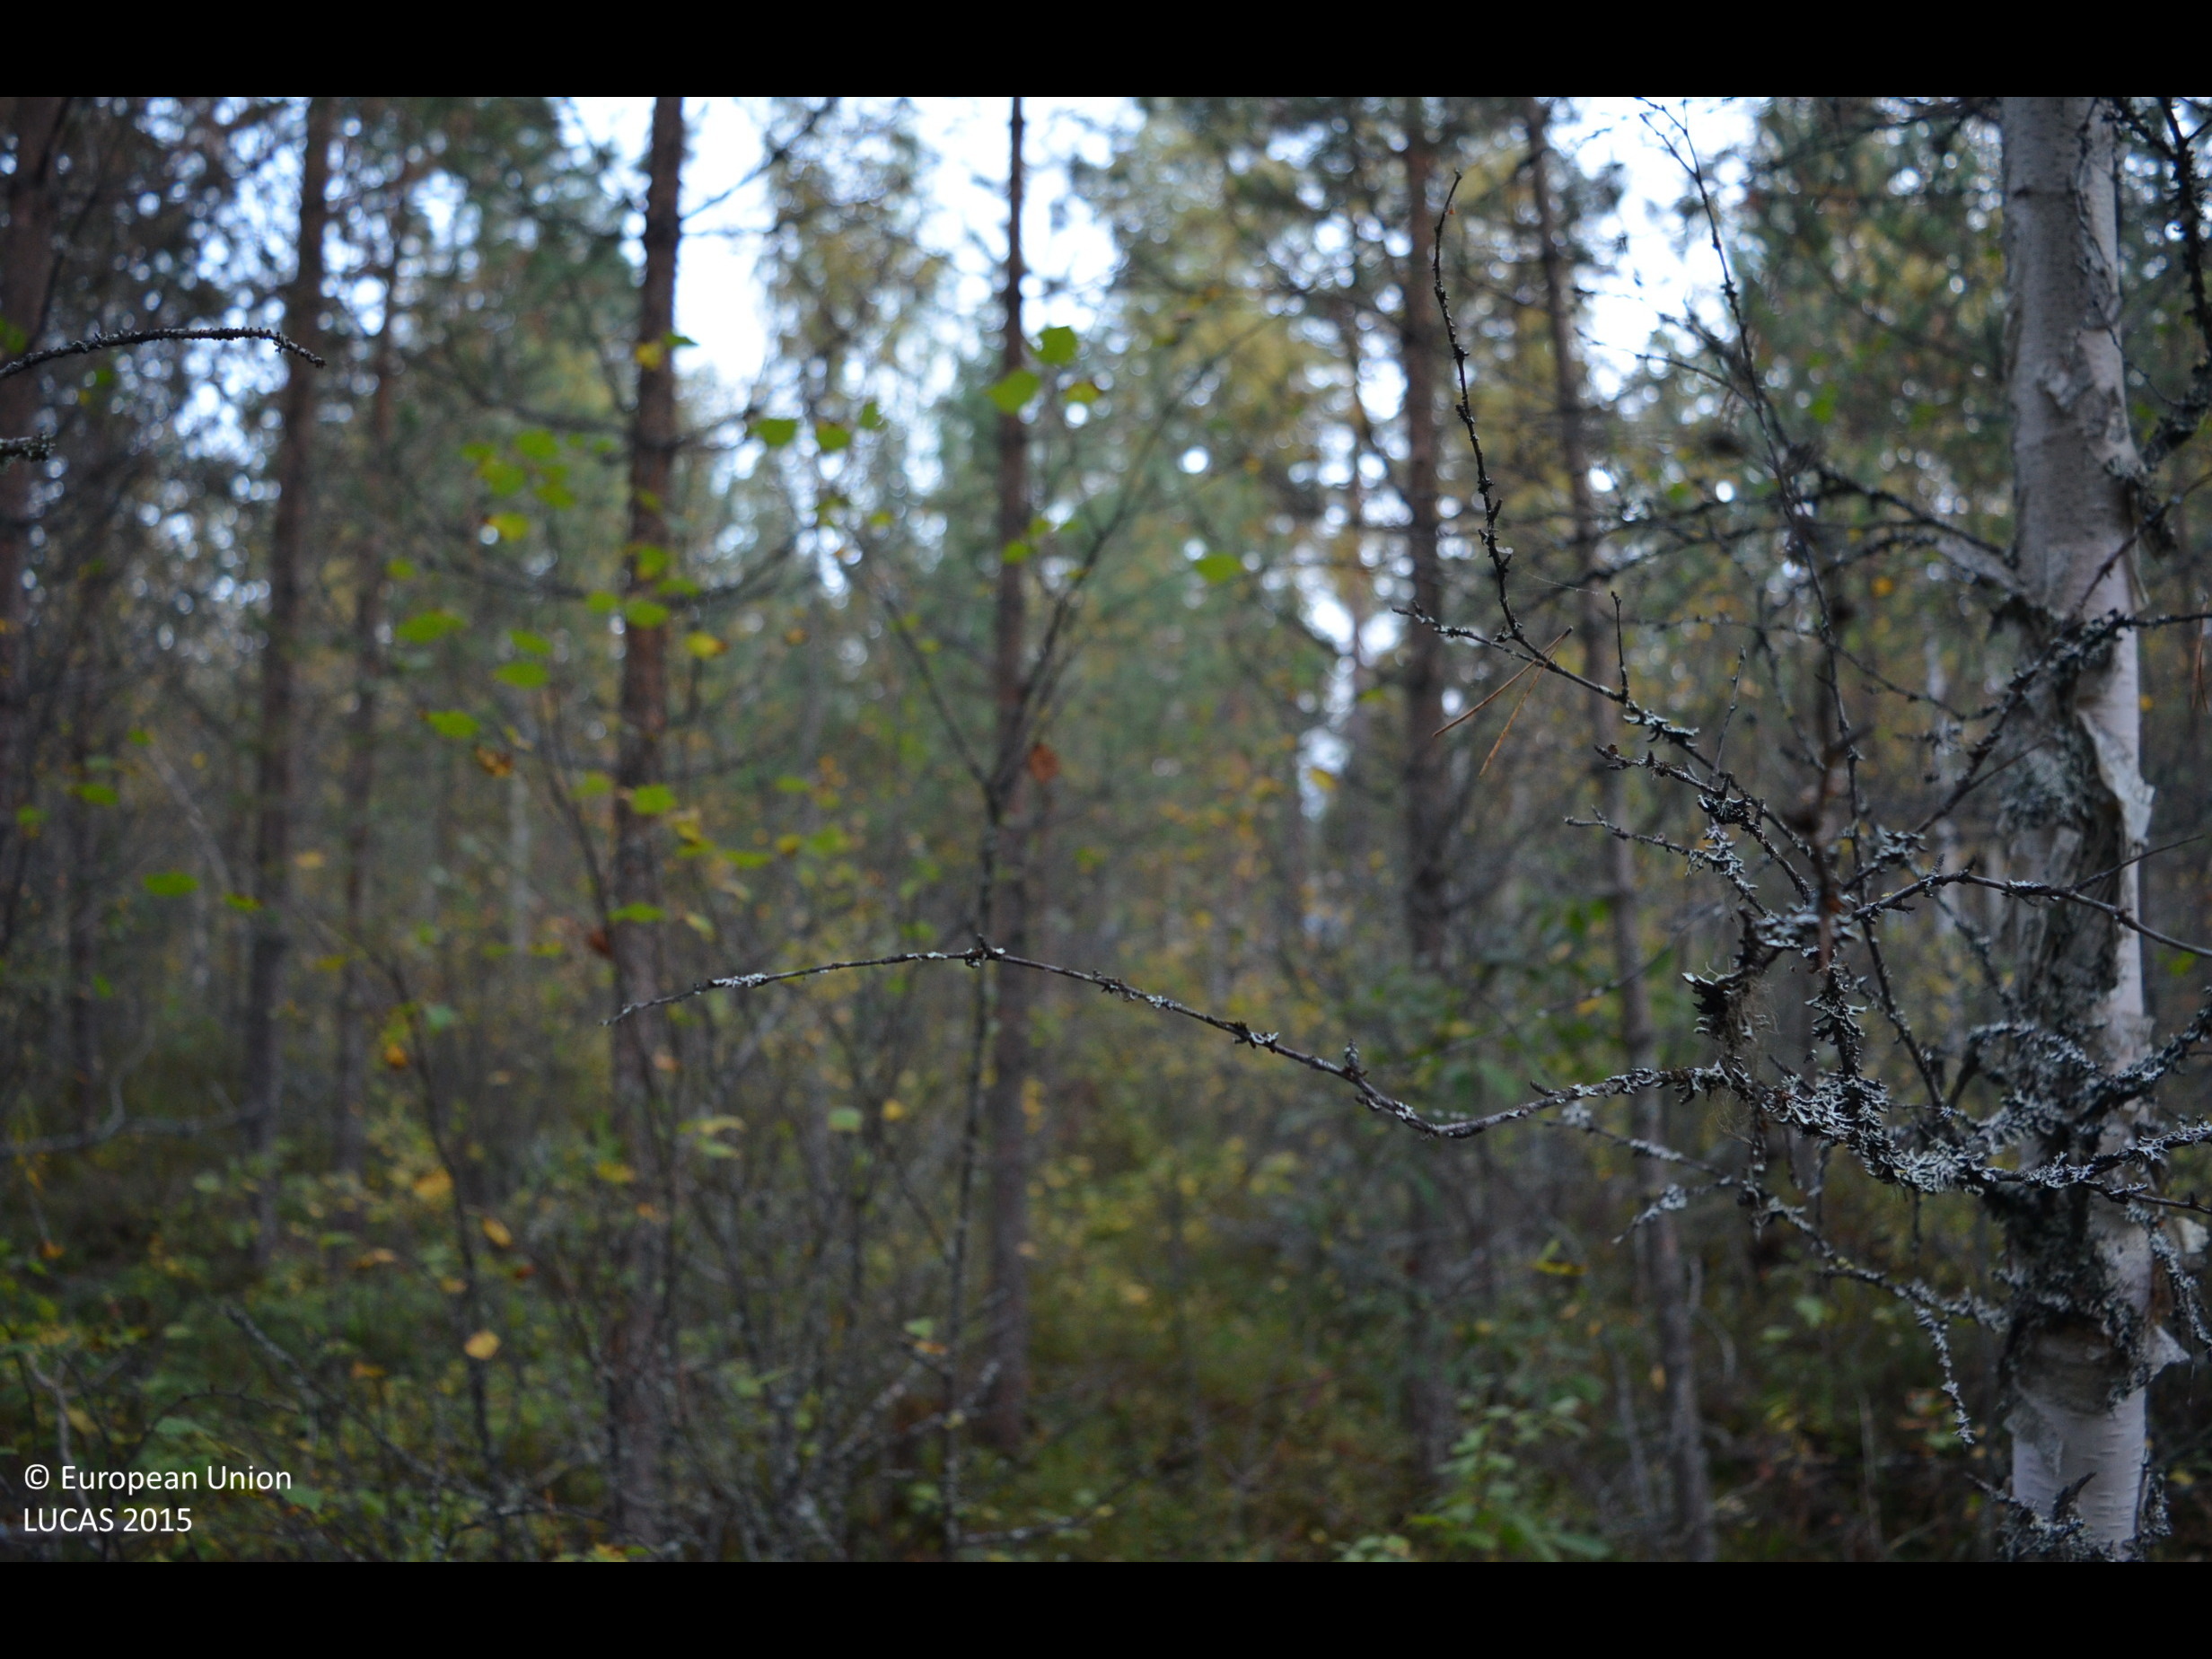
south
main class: Woodland
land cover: Pine dominated mixed woodland
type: boreal forest
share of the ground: > 75 %
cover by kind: coniferous forest trees 55 %, broadleaved forest trees 30 %, shrubs 15 %
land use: Forestry
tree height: > 5 m
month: September
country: FI
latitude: 62.8150
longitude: 23.8273
